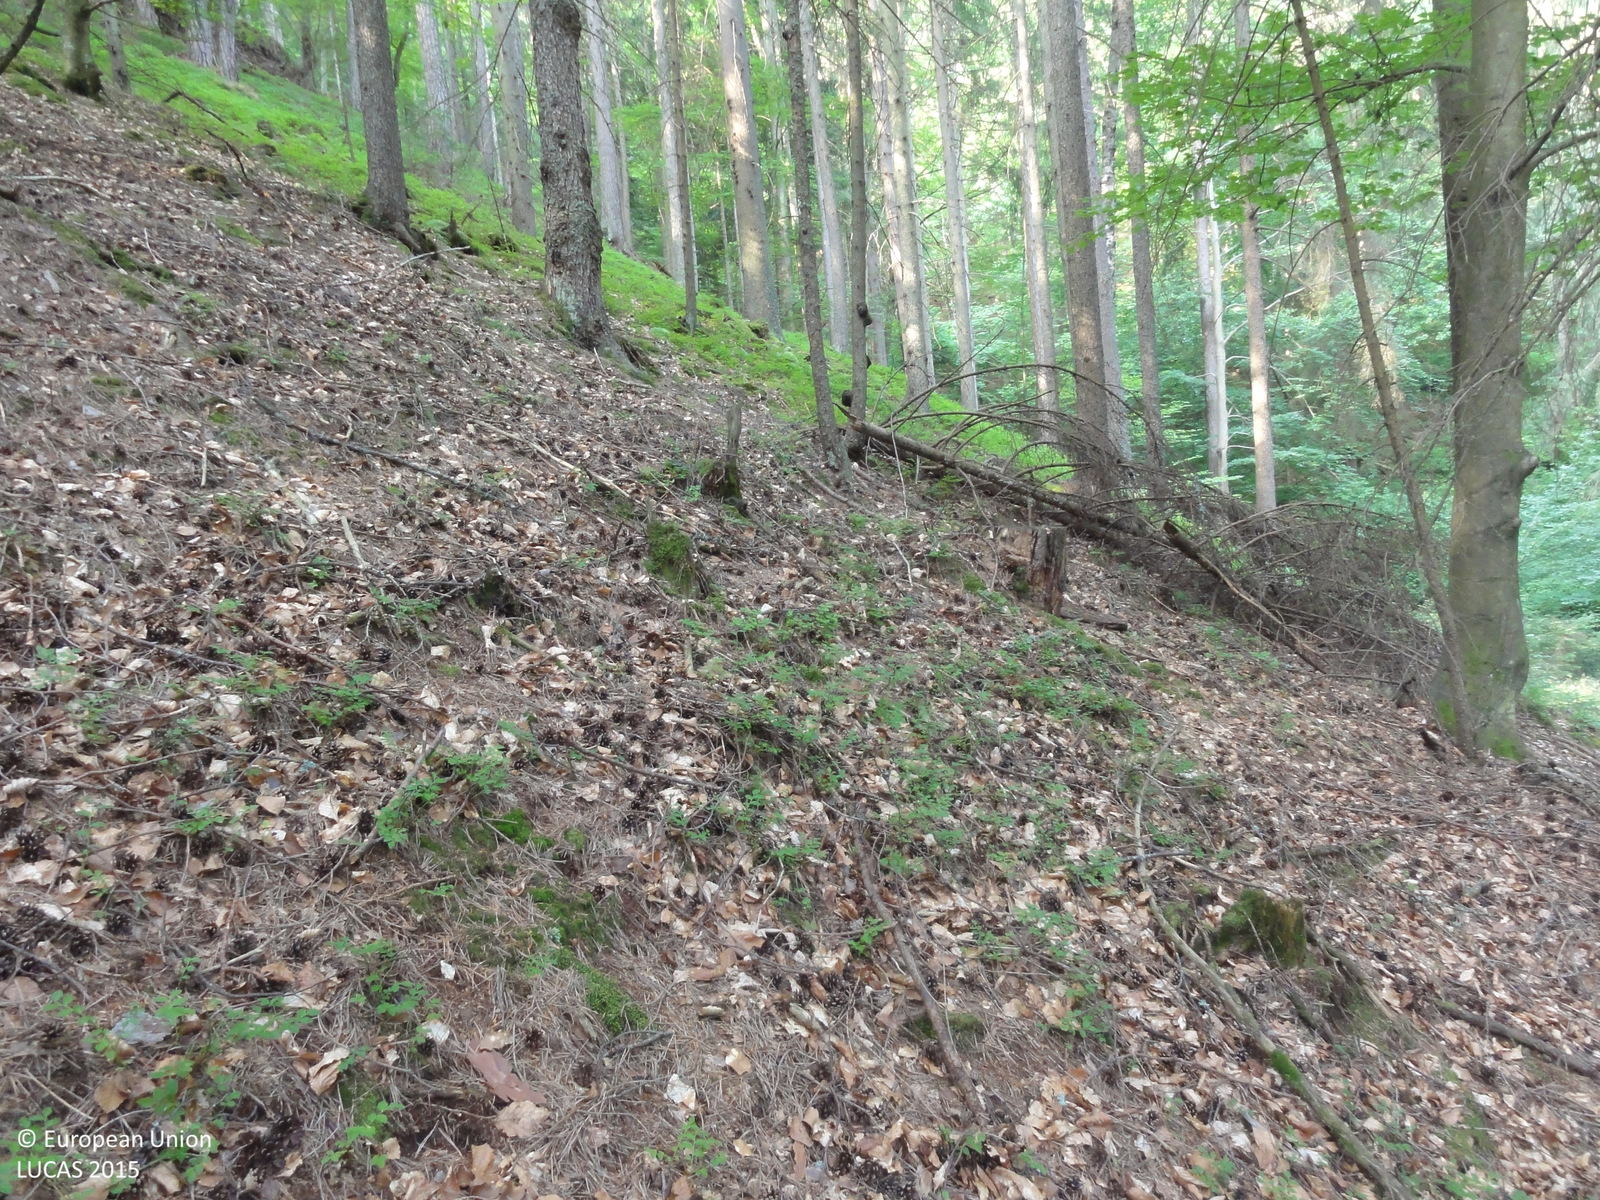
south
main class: Woodland
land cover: Other mixed woodland
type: mountainous beech forest
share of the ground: > 75 %
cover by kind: coniferous forest trees 60 %, broadleaved forest trees 40 %
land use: Forestry
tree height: > 5 m
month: July
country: SI
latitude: 46.6169
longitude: 14.9210
